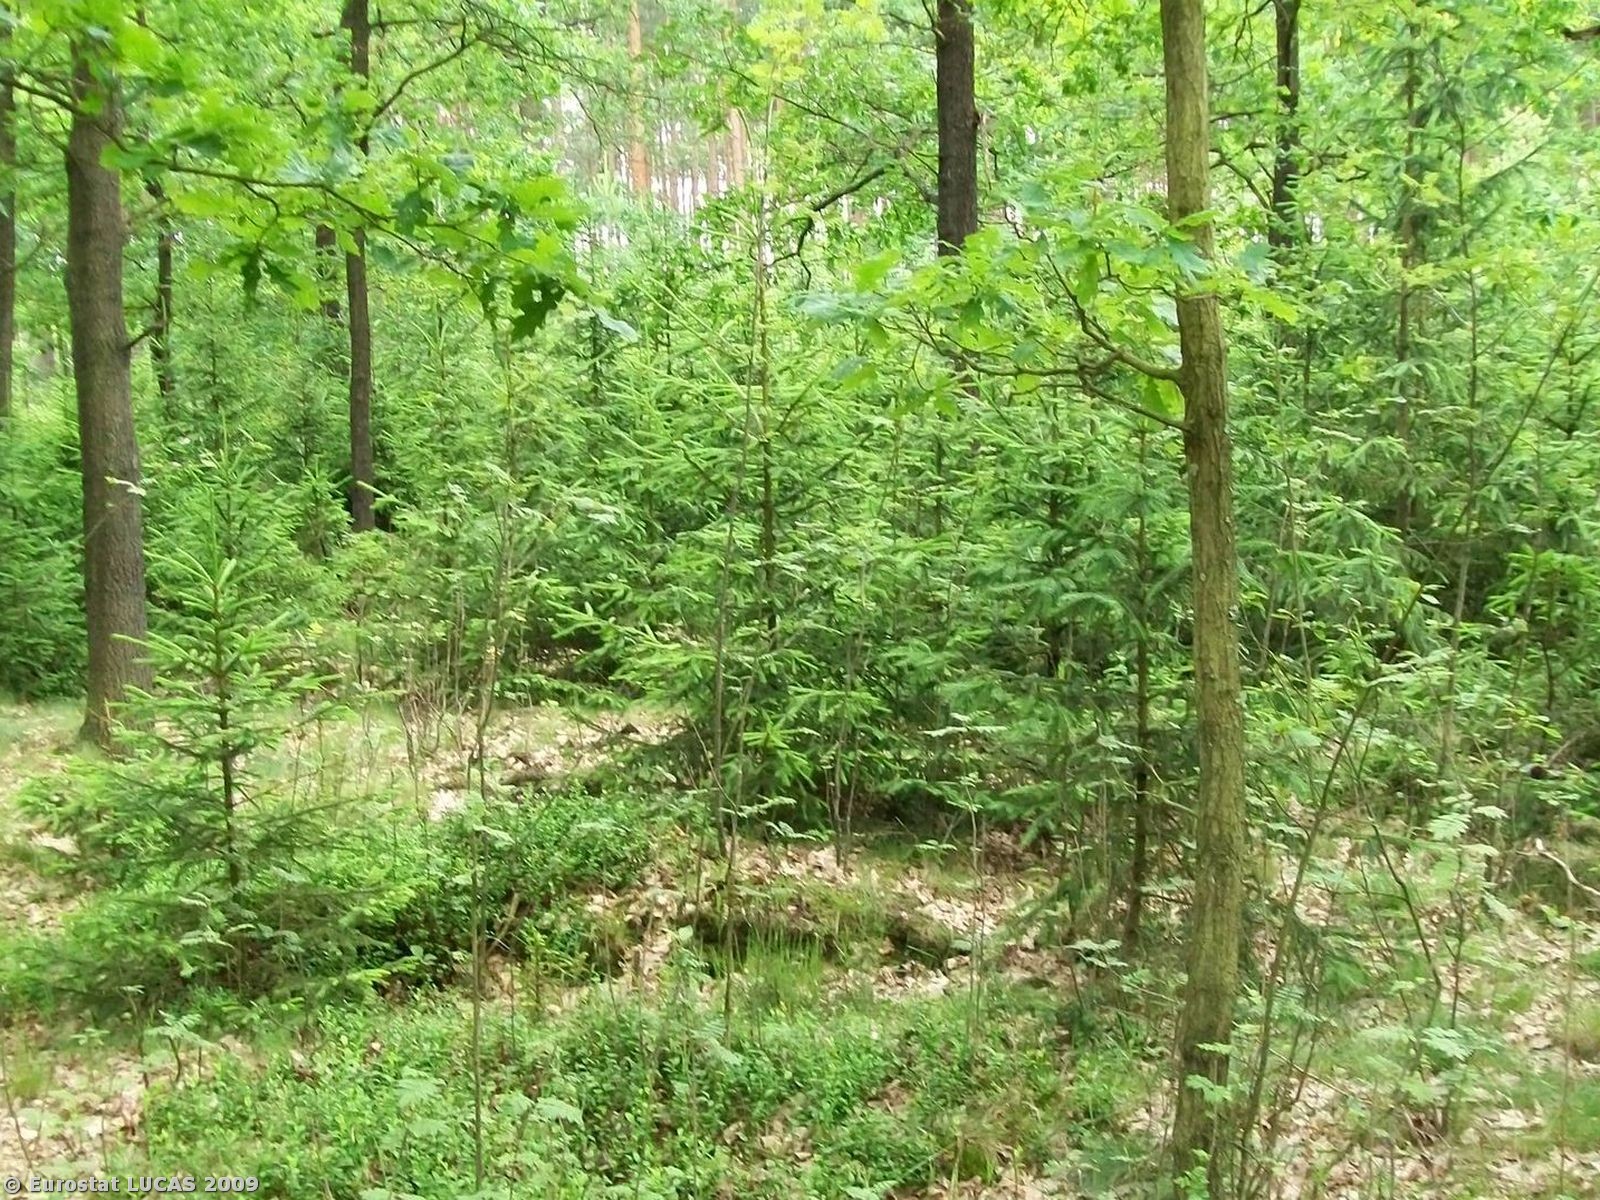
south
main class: Woodland
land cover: Mixed woodland
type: hemiboreal forest and nemoral coniferous forest and mixed broadleaved-coniferous forest
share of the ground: > 75 %
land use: Unused
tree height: > 5 m
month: September
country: PL
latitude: 50.8515
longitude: 17.8700
